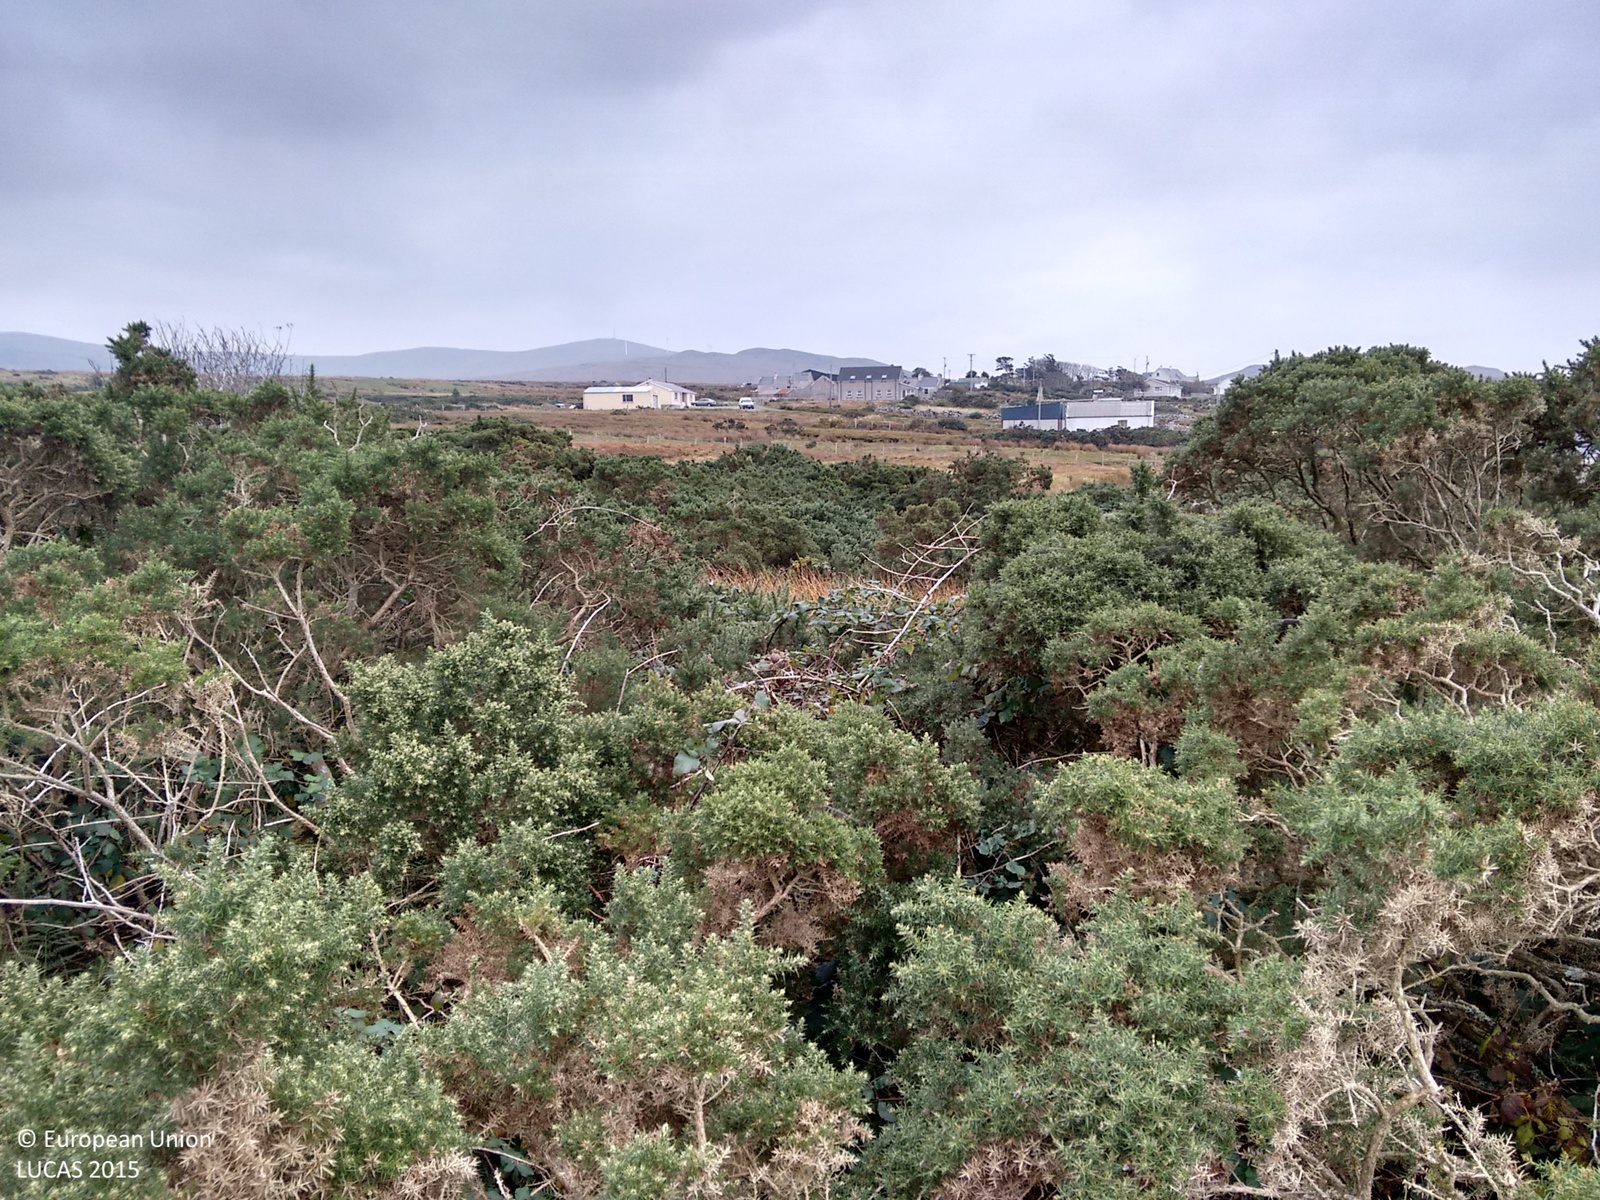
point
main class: Shrubland
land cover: Shrubland without tree cover
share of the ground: > 75 %
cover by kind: shrubs 40 %, herbaceous plants 40 %, lichens and mosses 20 %
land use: Agriculture (excluding fallow land and kitchen gardens)
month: November
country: IE
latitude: 55.0797
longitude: -8.2728
